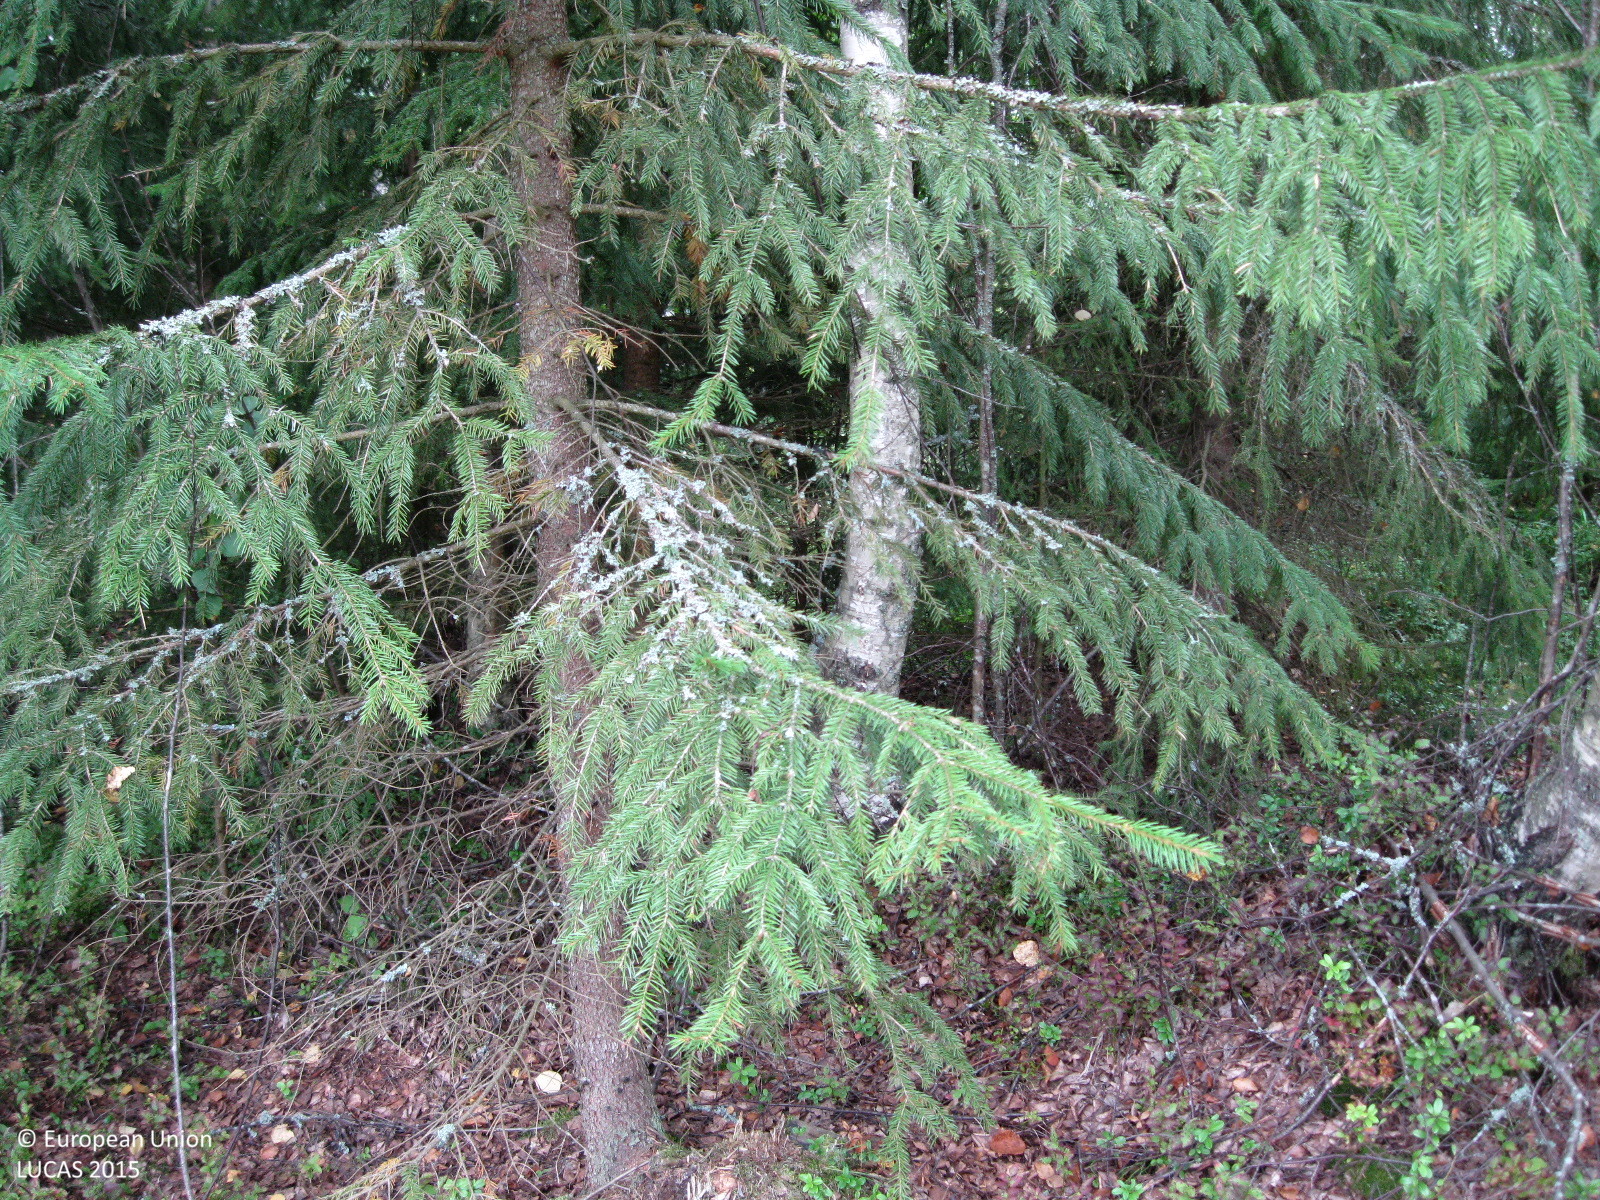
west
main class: Woodland
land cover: Spruce dominated mixed woodland
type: boreal forest
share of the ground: > 75 %
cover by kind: broadleaved forest trees 45 %, coniferous forest trees 40 %, herbaceous plants 10 %, shrubs 5 %
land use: Forestry
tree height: > 5 m
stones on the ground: < 10 %
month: September
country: FI
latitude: 60.8523
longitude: 25.0802
